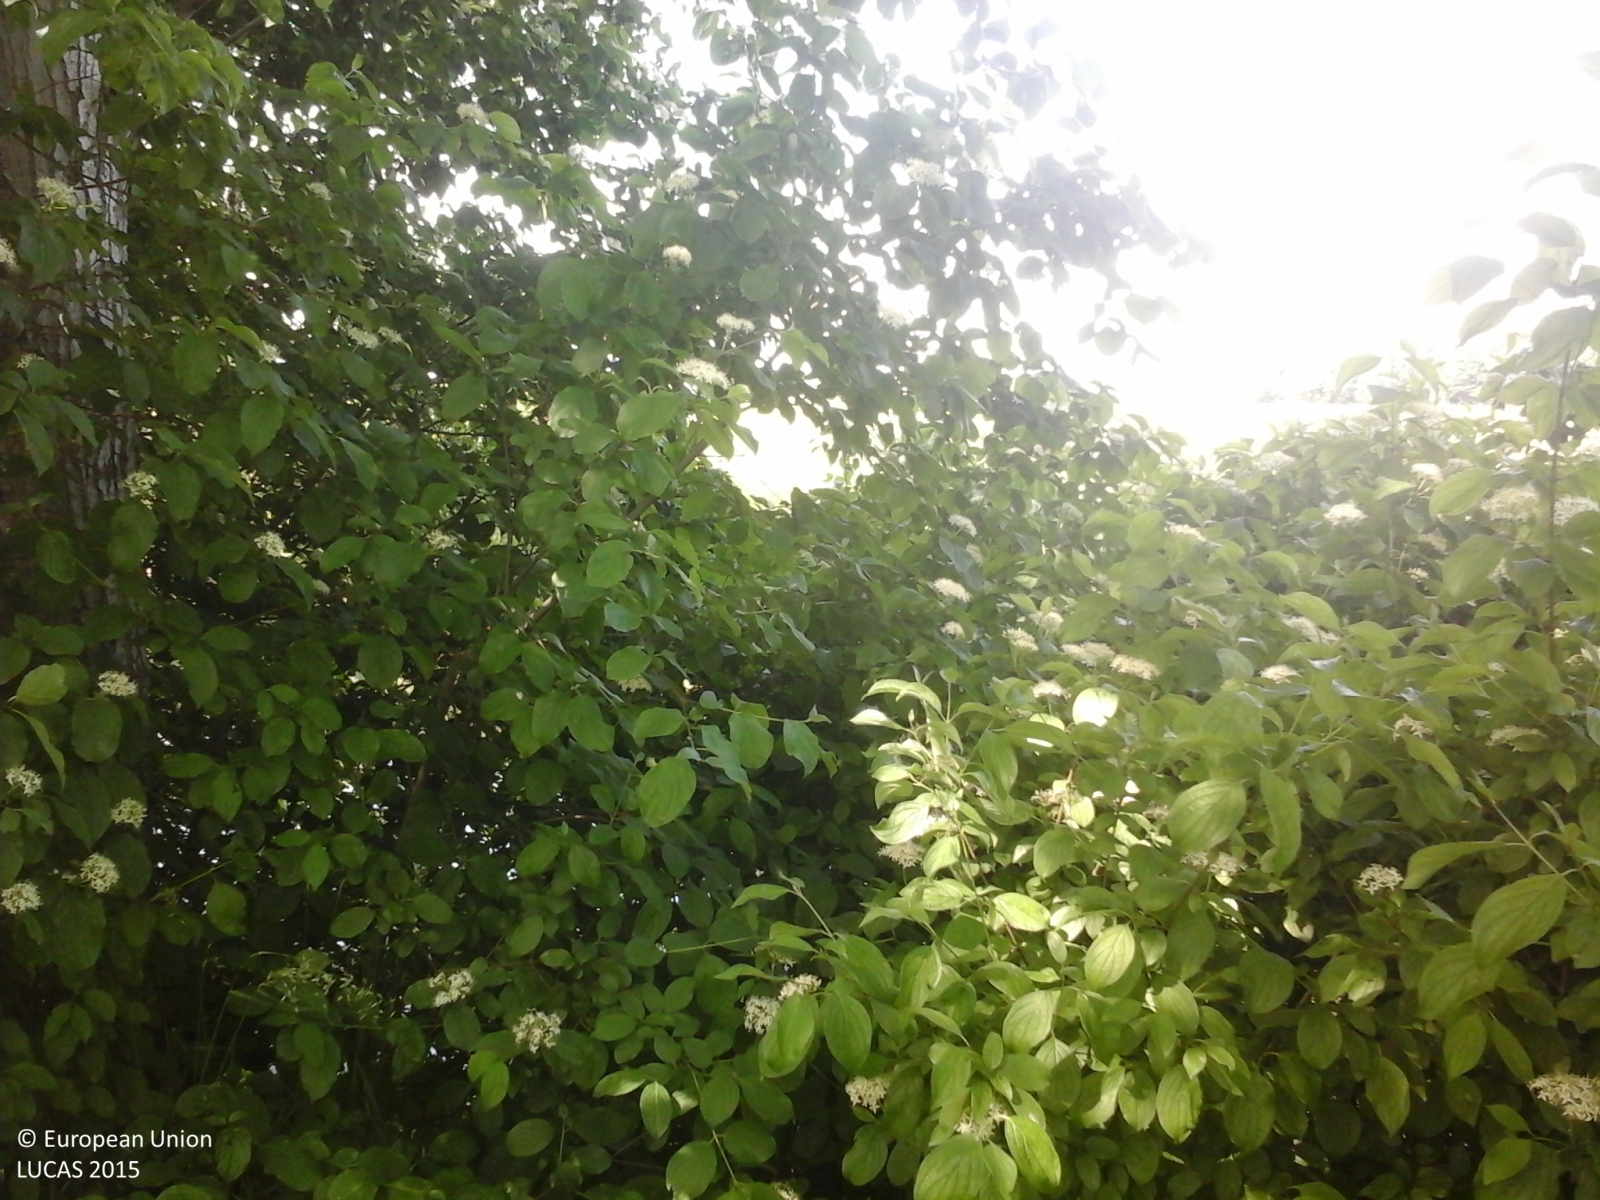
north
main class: Woodland
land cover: Broadleaved woodland
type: non-riverine alder, birch or aspen forest
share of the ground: > 75 %
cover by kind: broadleaved forest trees 100 %
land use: Forestry
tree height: > 5 m
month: May
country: IT
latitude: 45.0307
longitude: 11.0261
